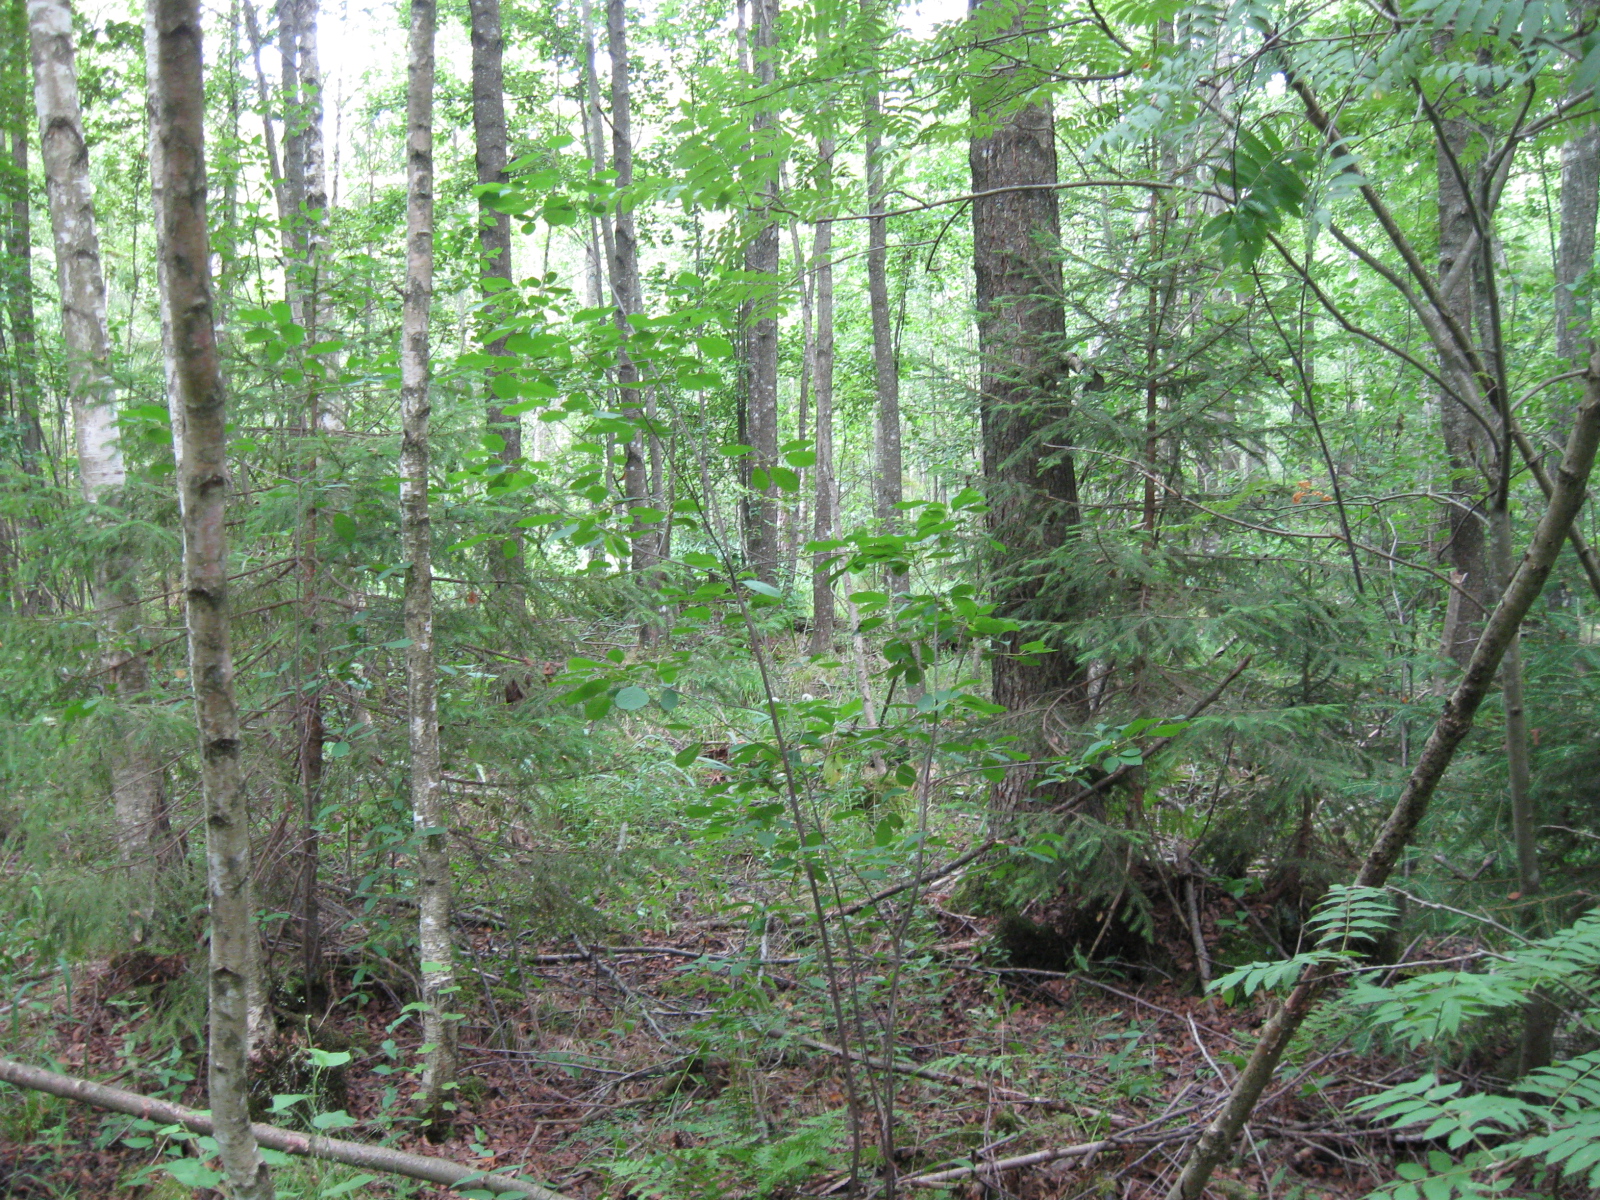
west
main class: Woodland
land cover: Broadleaved woodland
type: non-riverine alder, birch or aspen forest
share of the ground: > 75 %
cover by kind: broadleaved forest trees 75 %, herbaceous plants 10 %, coniferous forest trees 5 %, shrubs 5 %, lichens and mosses 5 %
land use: Forestry
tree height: > 5 m
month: July
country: LT
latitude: 54.7698
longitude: 23.5591
